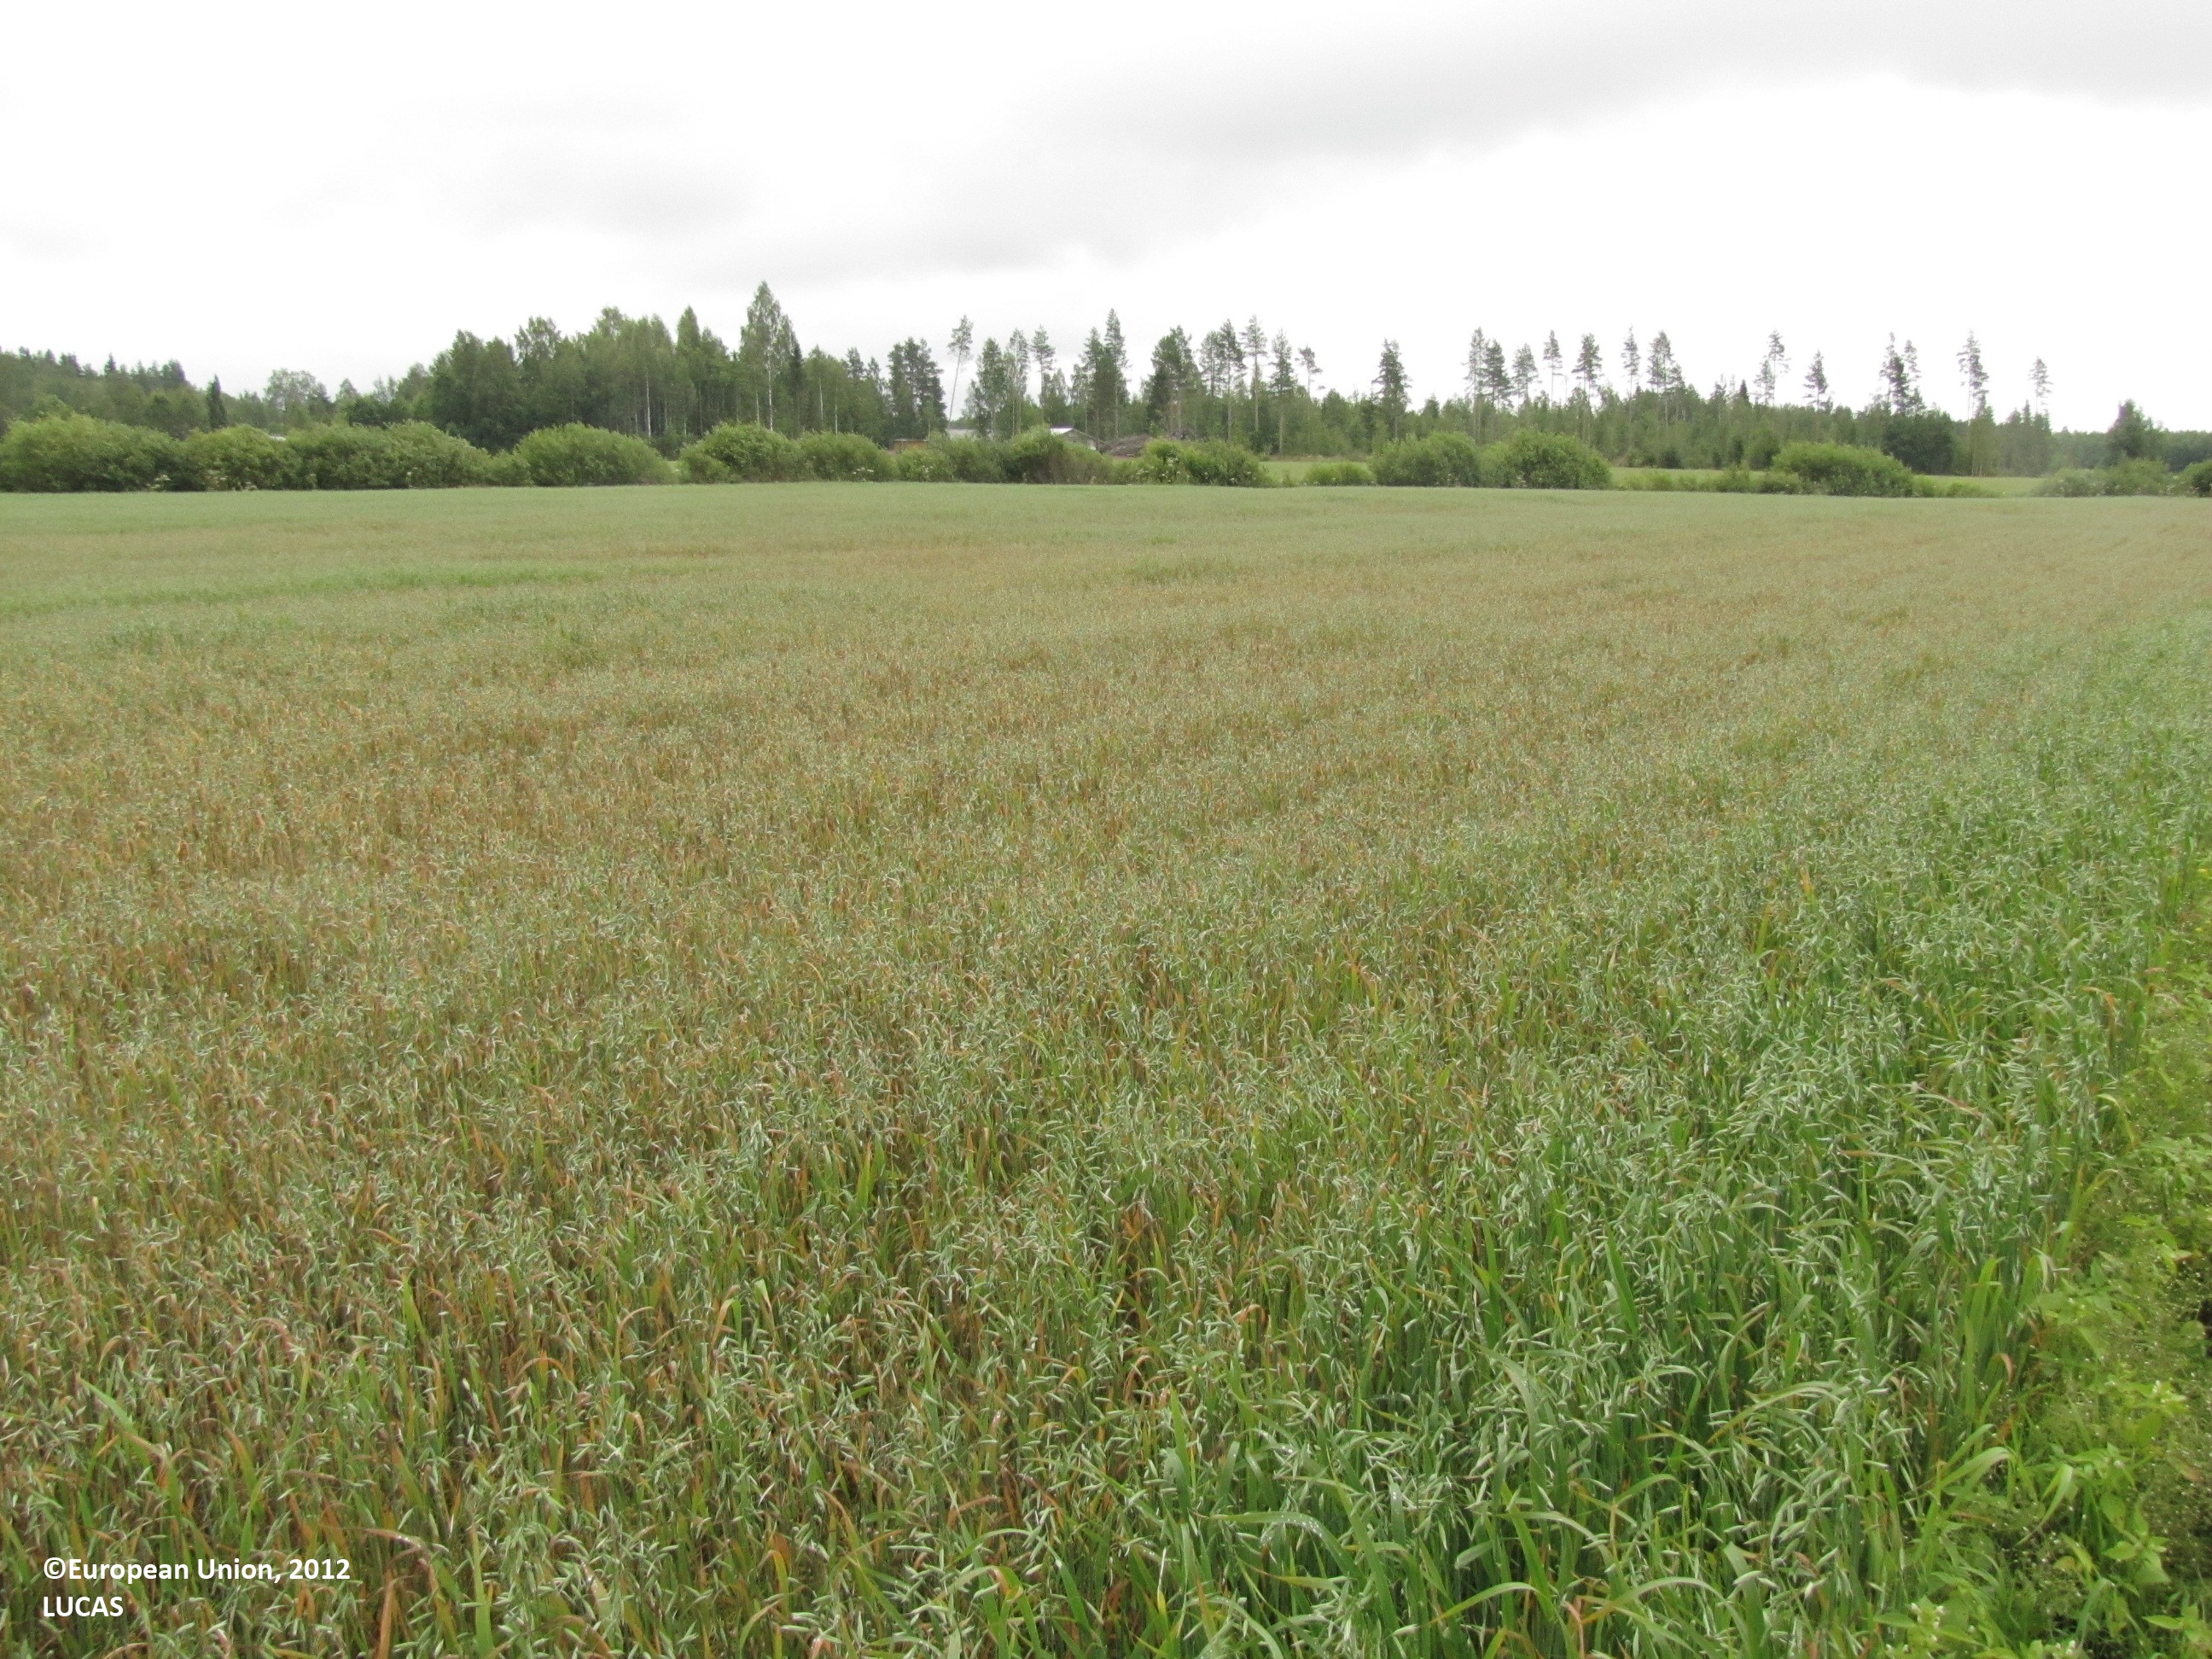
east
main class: Cropland
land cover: Oats
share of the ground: > 75 %
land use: Agriculture (excluding fallow land and kitchen gardens)
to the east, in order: Oats; Grass margins; Ditches and canals; Abandoned hedges; Common wheat; Ditches and canals; Abandoned hedges; Spruce dominated mixed woodland
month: July
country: FI
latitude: 62.1926
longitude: 22.9973
